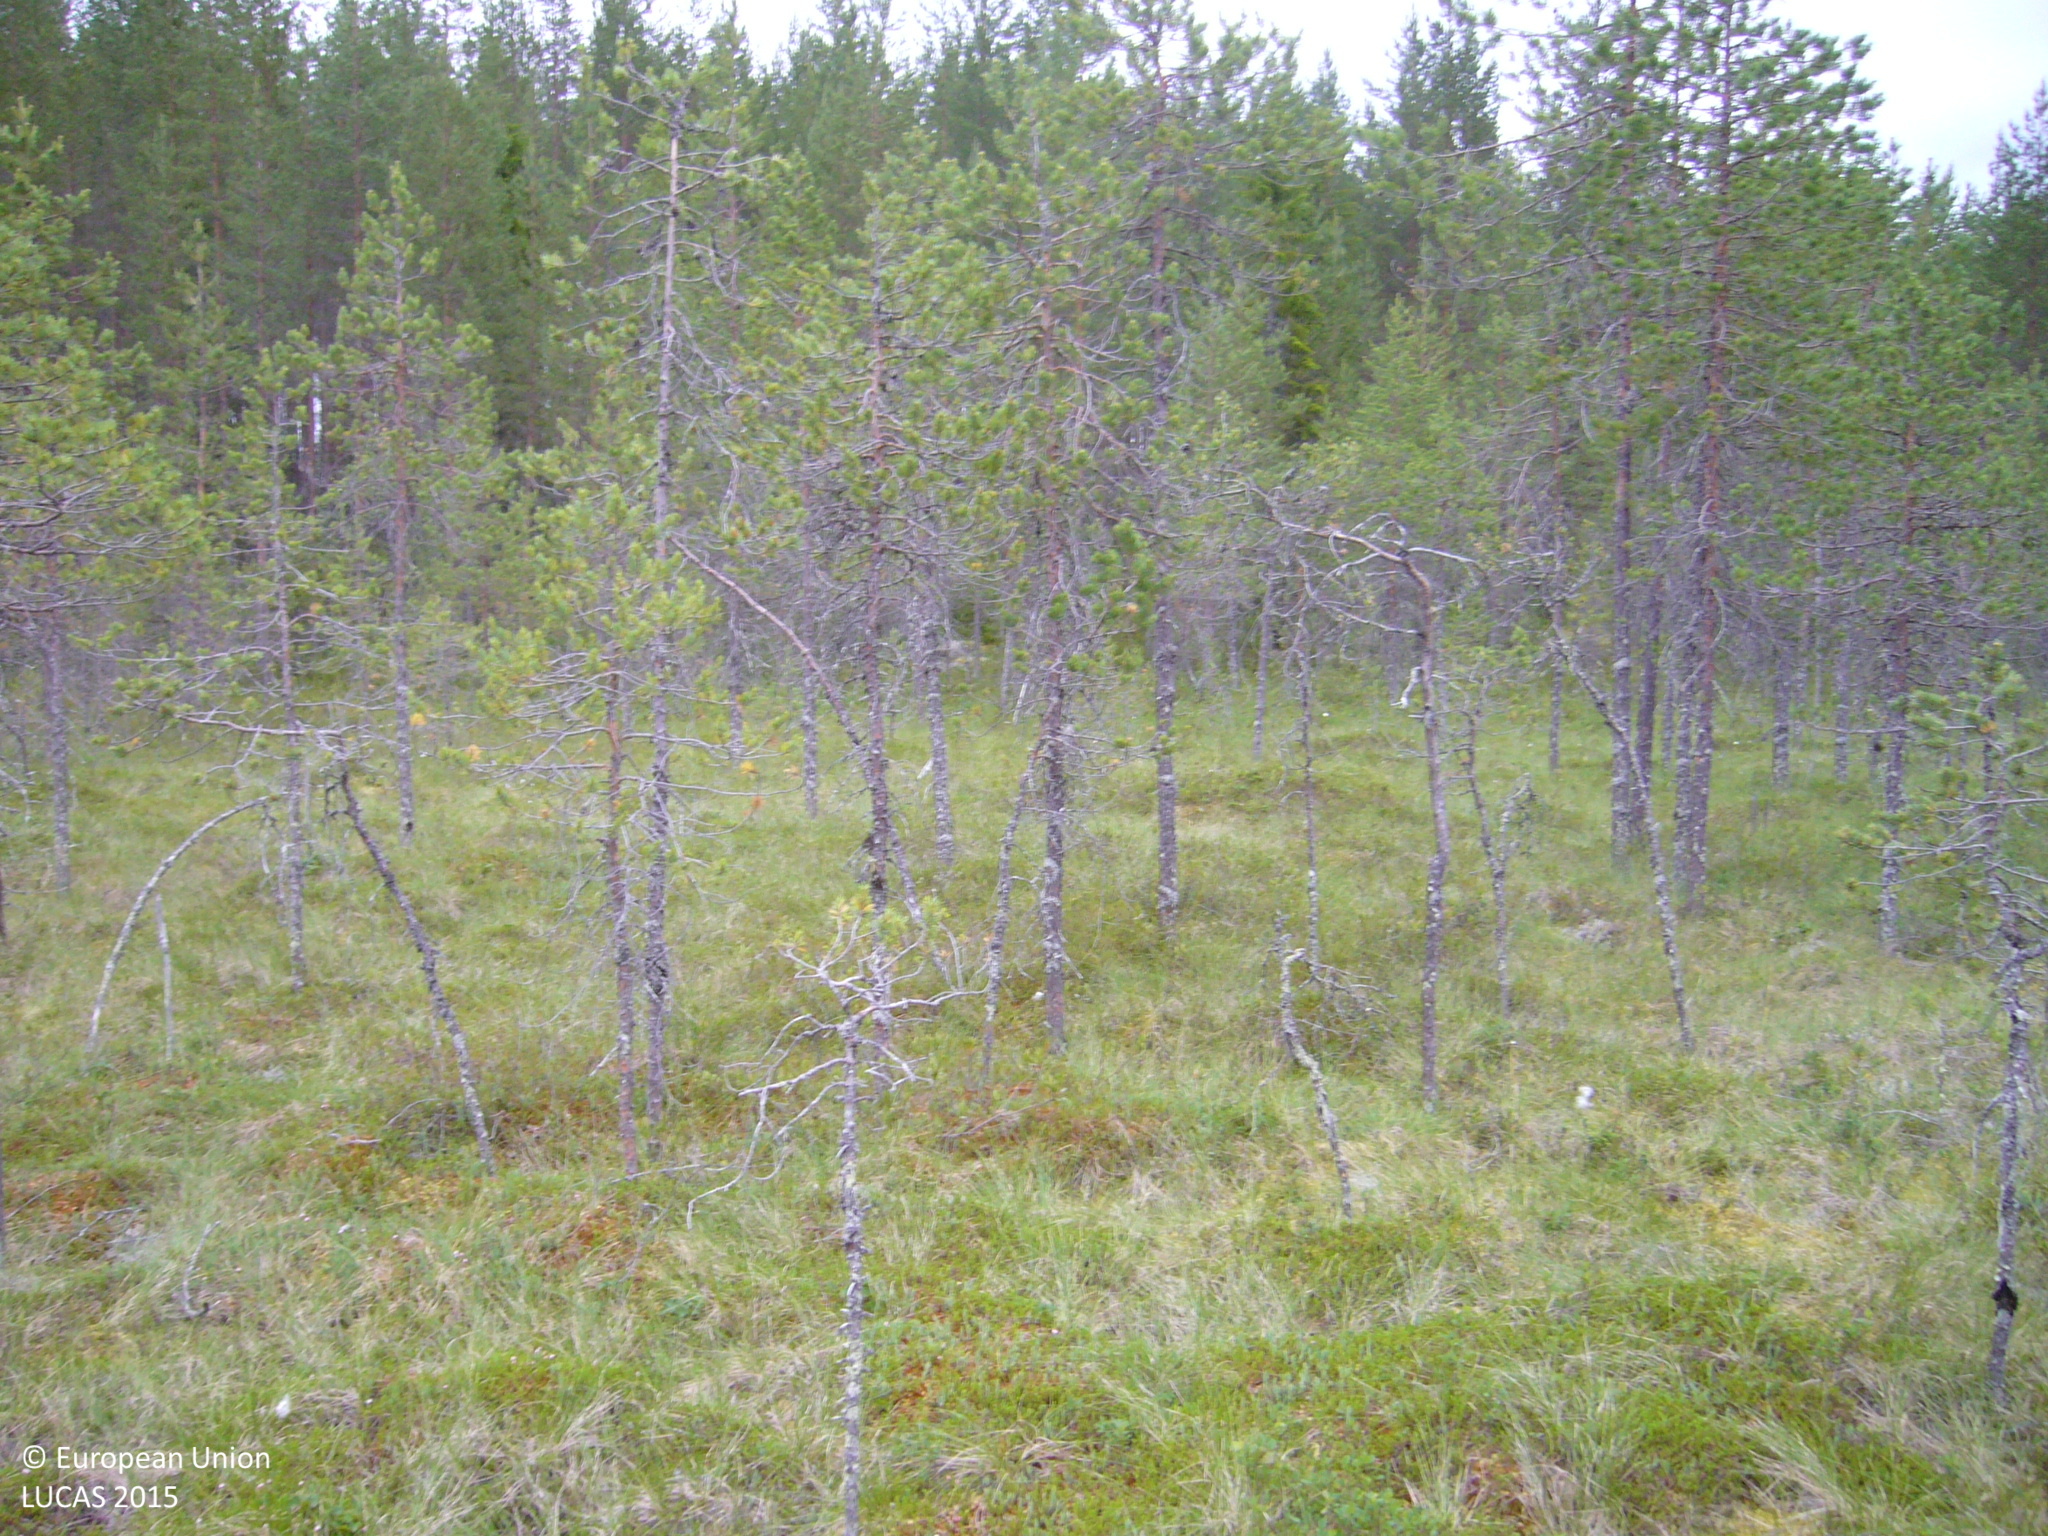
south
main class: Woodland
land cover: Pine dominated coniferous woodland
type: mire and swamp forests
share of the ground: 25 - 50 %
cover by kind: lichens and mosses 65 %, coniferous forest trees 25 %, herbaceous plants 10 %
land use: Semi-natural and natural areas not in use
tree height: < 5 m
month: July
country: FI
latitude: 63.5119
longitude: 25.9273
